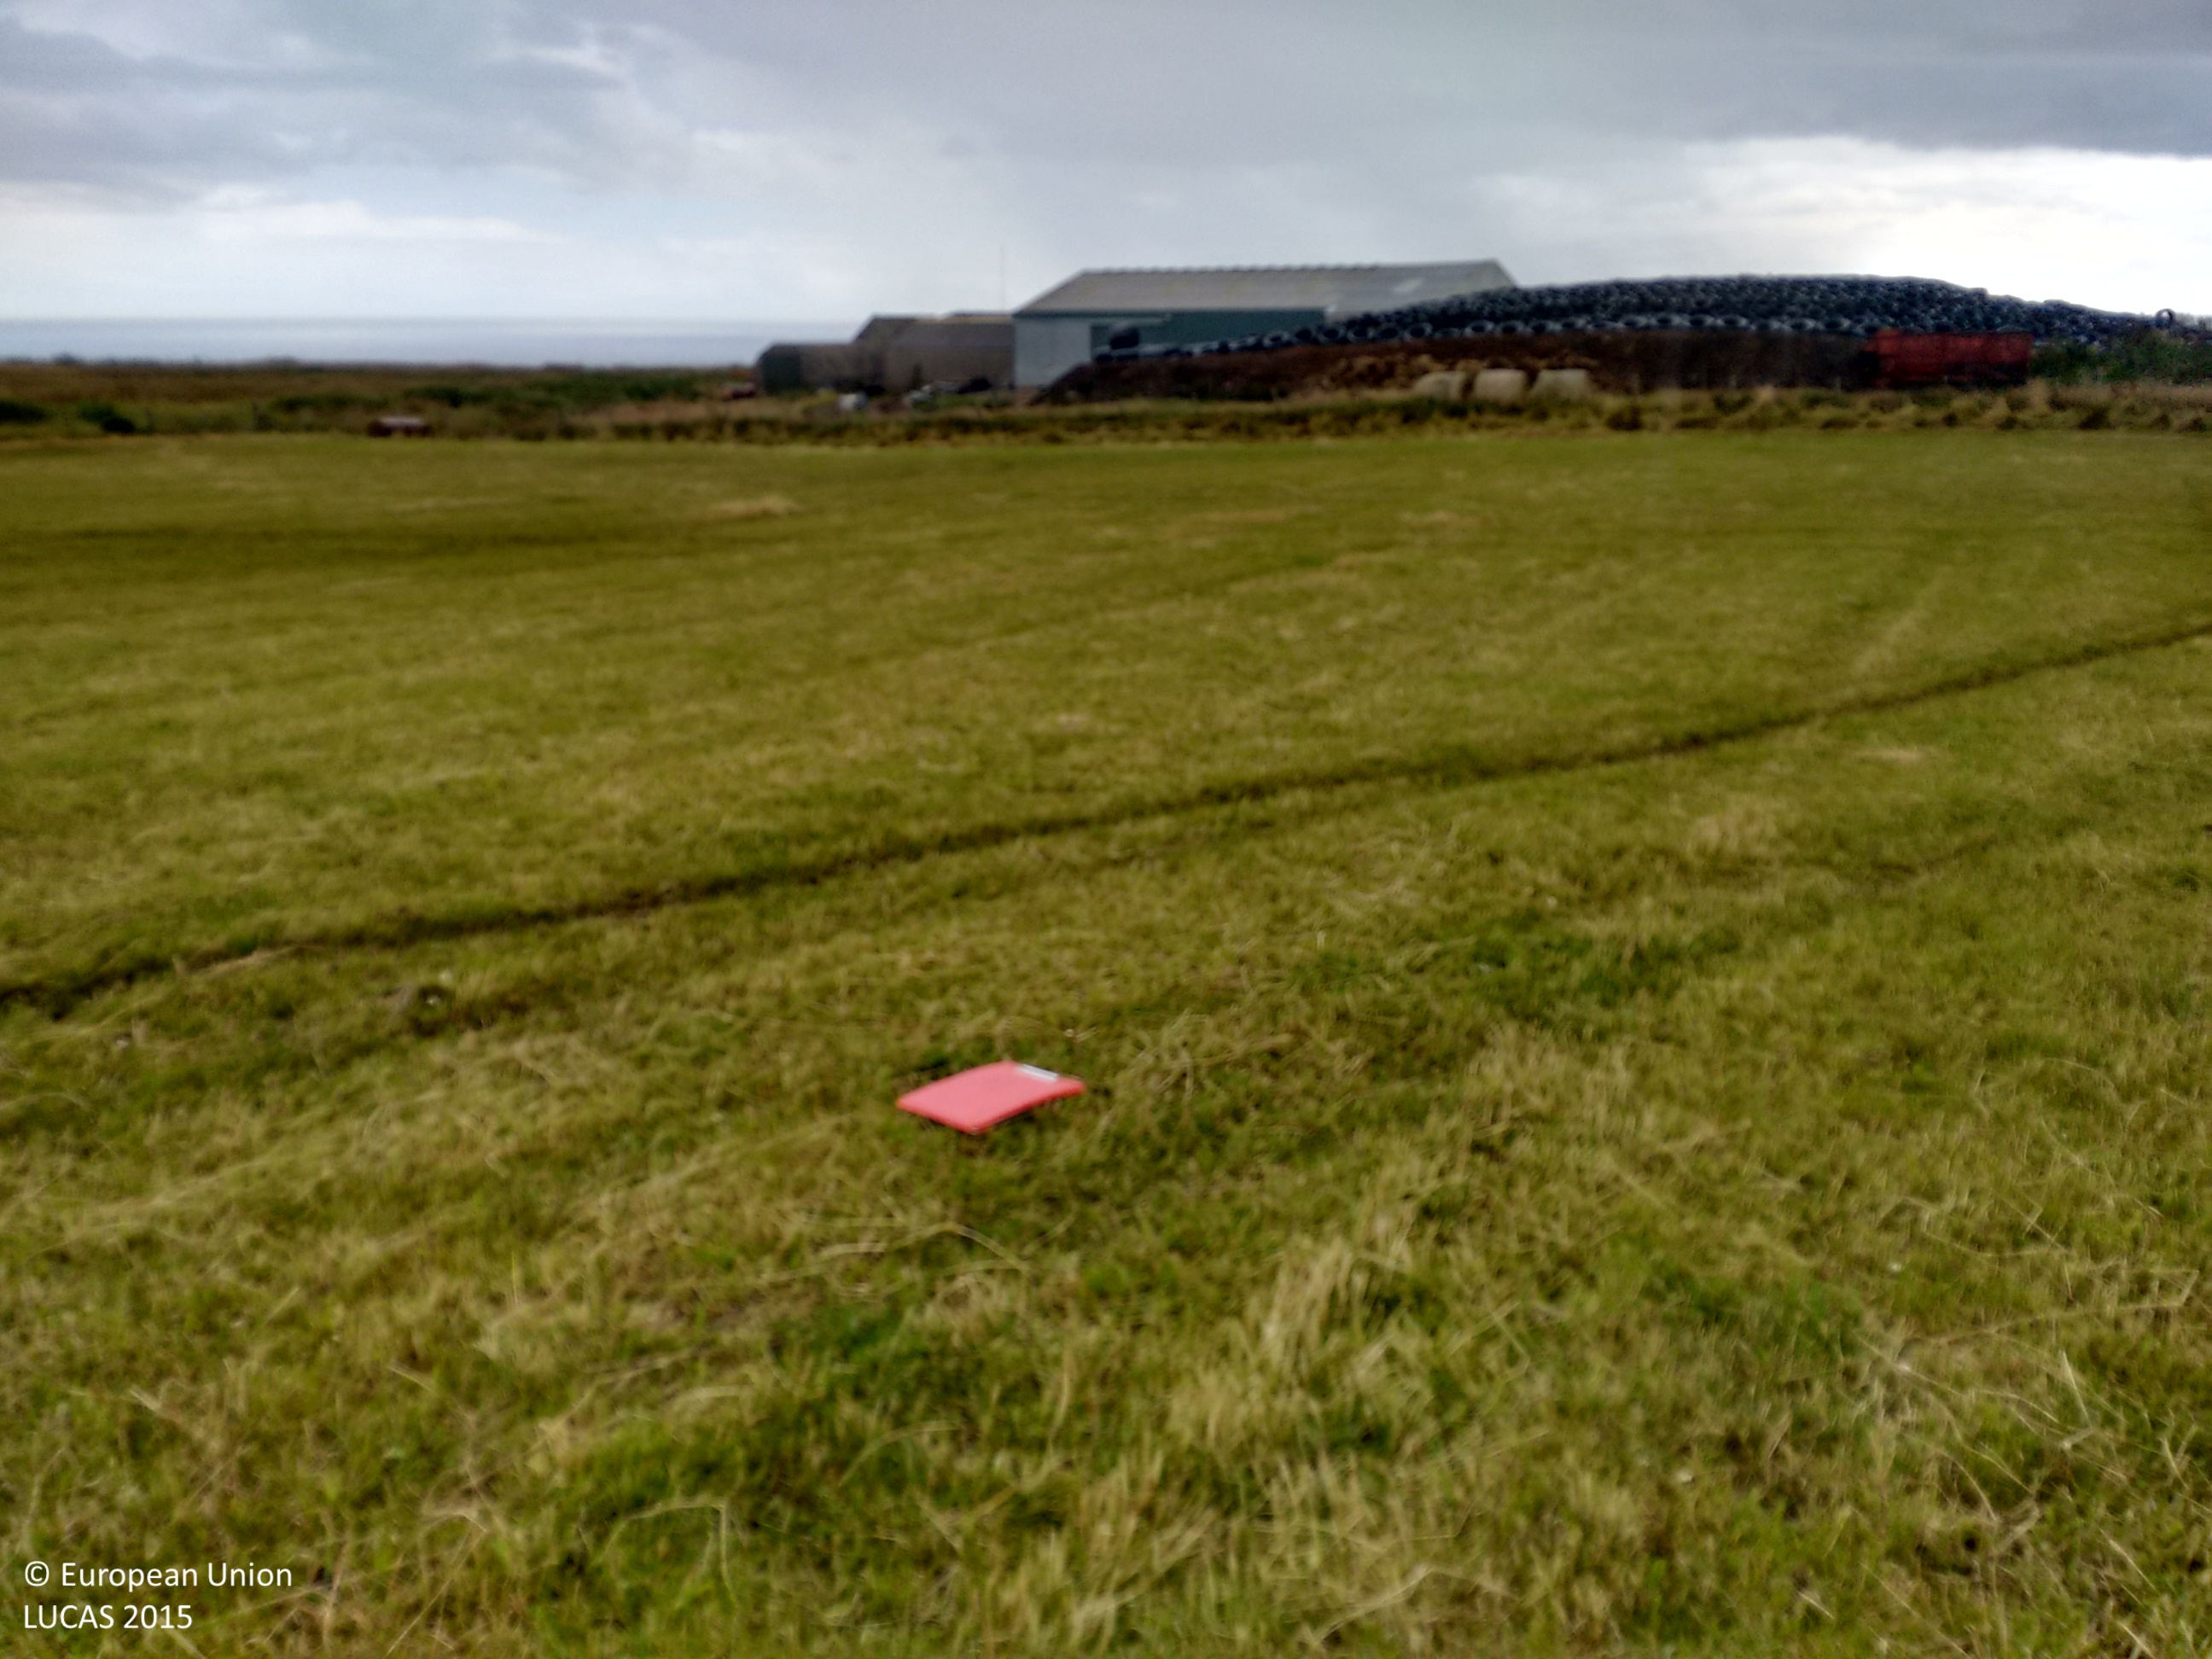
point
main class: Grassland
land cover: Grassland without tree/shrub cover
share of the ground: > 75 %
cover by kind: herbaceous plants 100 %
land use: Agriculture (excluding fallow land and kitchen gardens)
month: August
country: GB
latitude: 58.6025
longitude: -3.0489
